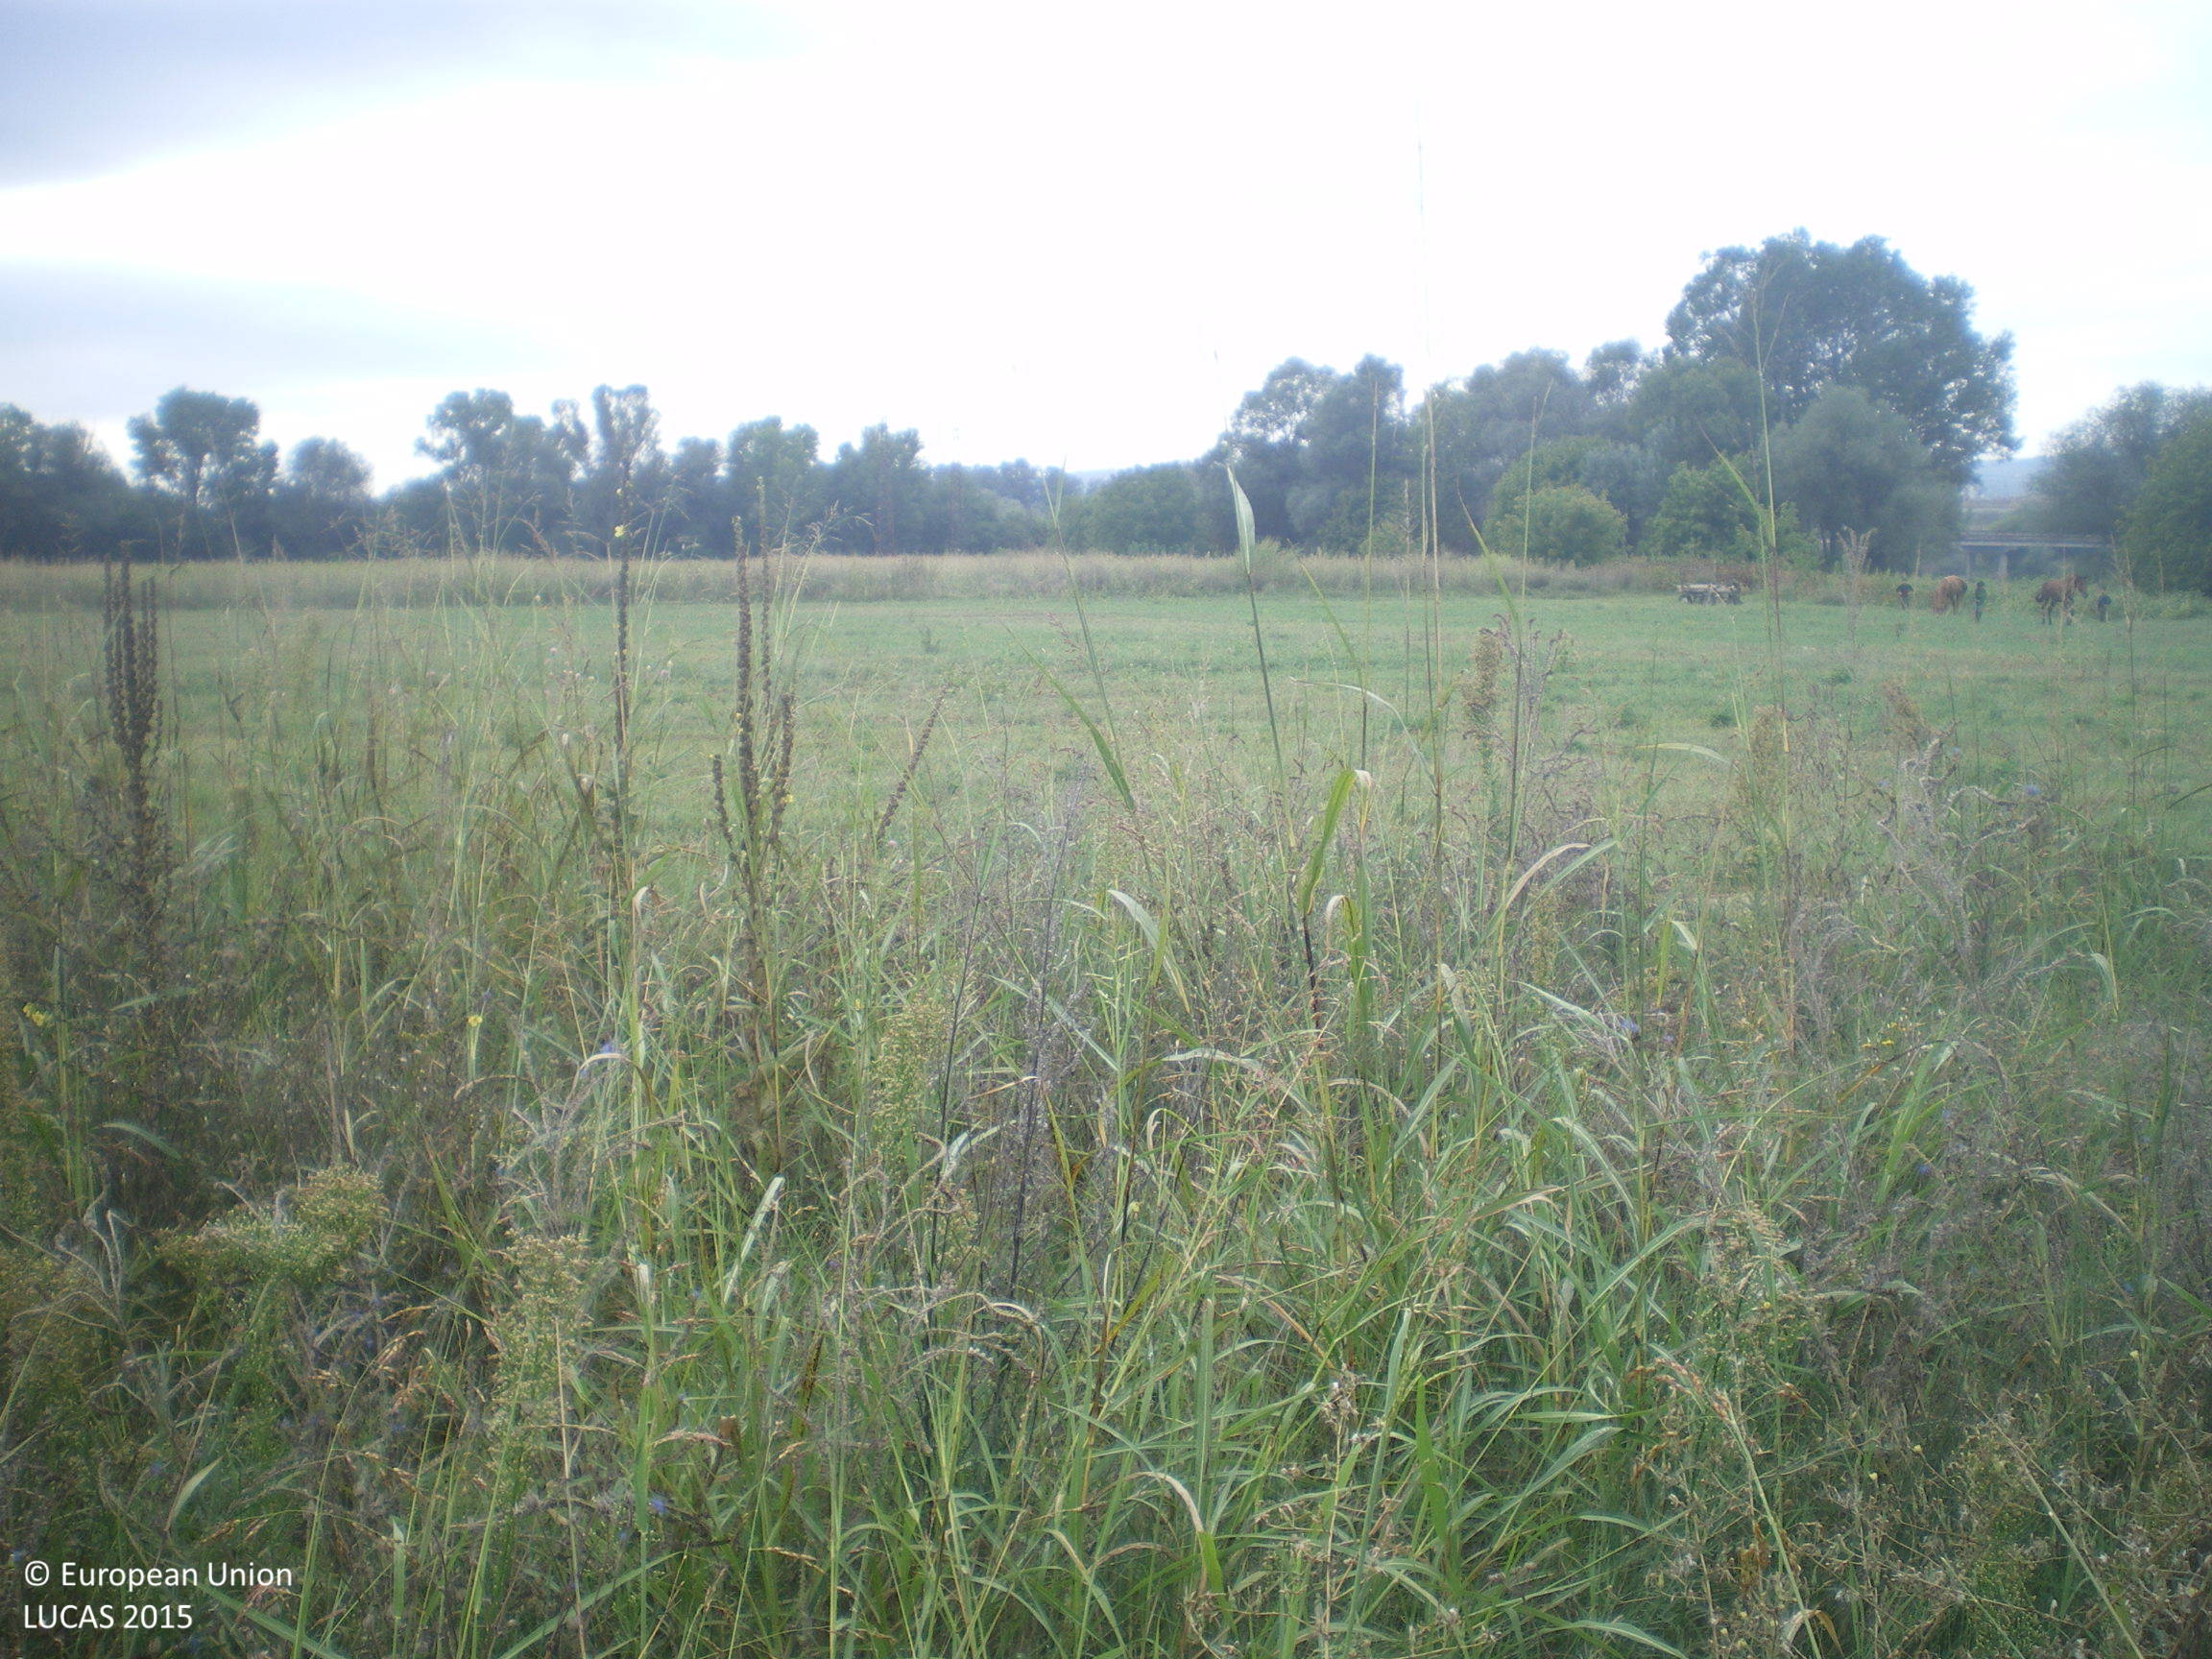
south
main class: Grassland
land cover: Spontaneously vegetated surfaces
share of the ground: > 75 %
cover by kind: herbaceous plants 100 %
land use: Fallow land
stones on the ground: < 10 %
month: September
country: BG
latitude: 41.9348
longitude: 25.9316
